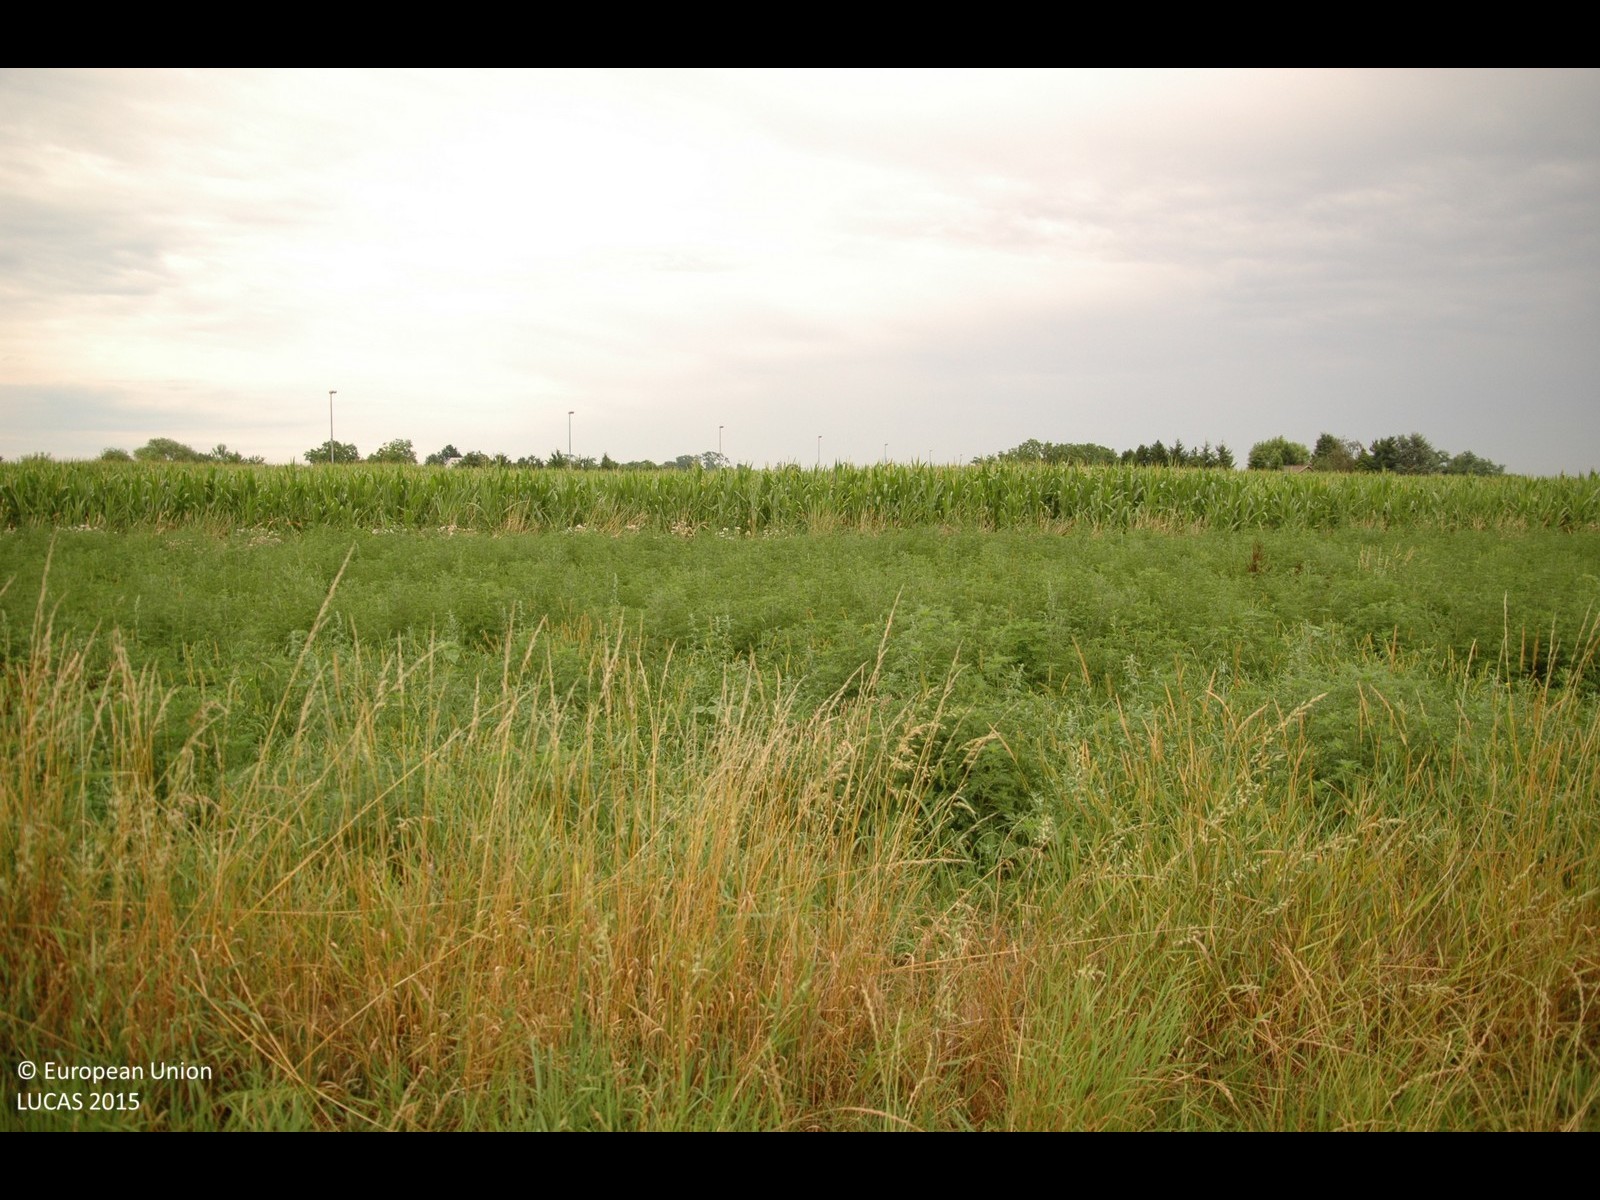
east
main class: Grassland
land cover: Grassland without tree/shrub cover
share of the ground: > 75 %
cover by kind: herbaceous plants 100 %
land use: Agriculture (excluding fallow land and kitchen gardens)
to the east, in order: Grassland without tree/shrub cover; Spontaneously vegetated surfaces; Maize; Barley; Maize; Common wheat; Spontaneously vegetated surfaces; Common wheat; Spontaneously vegetated surfaces; Tracks; Grassland without tree/shrub cover; Paved roads, cycling and walking lanes; Grass margins; Fences; Grass margins
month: July
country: HR
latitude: 46.3741
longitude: 16.4357
